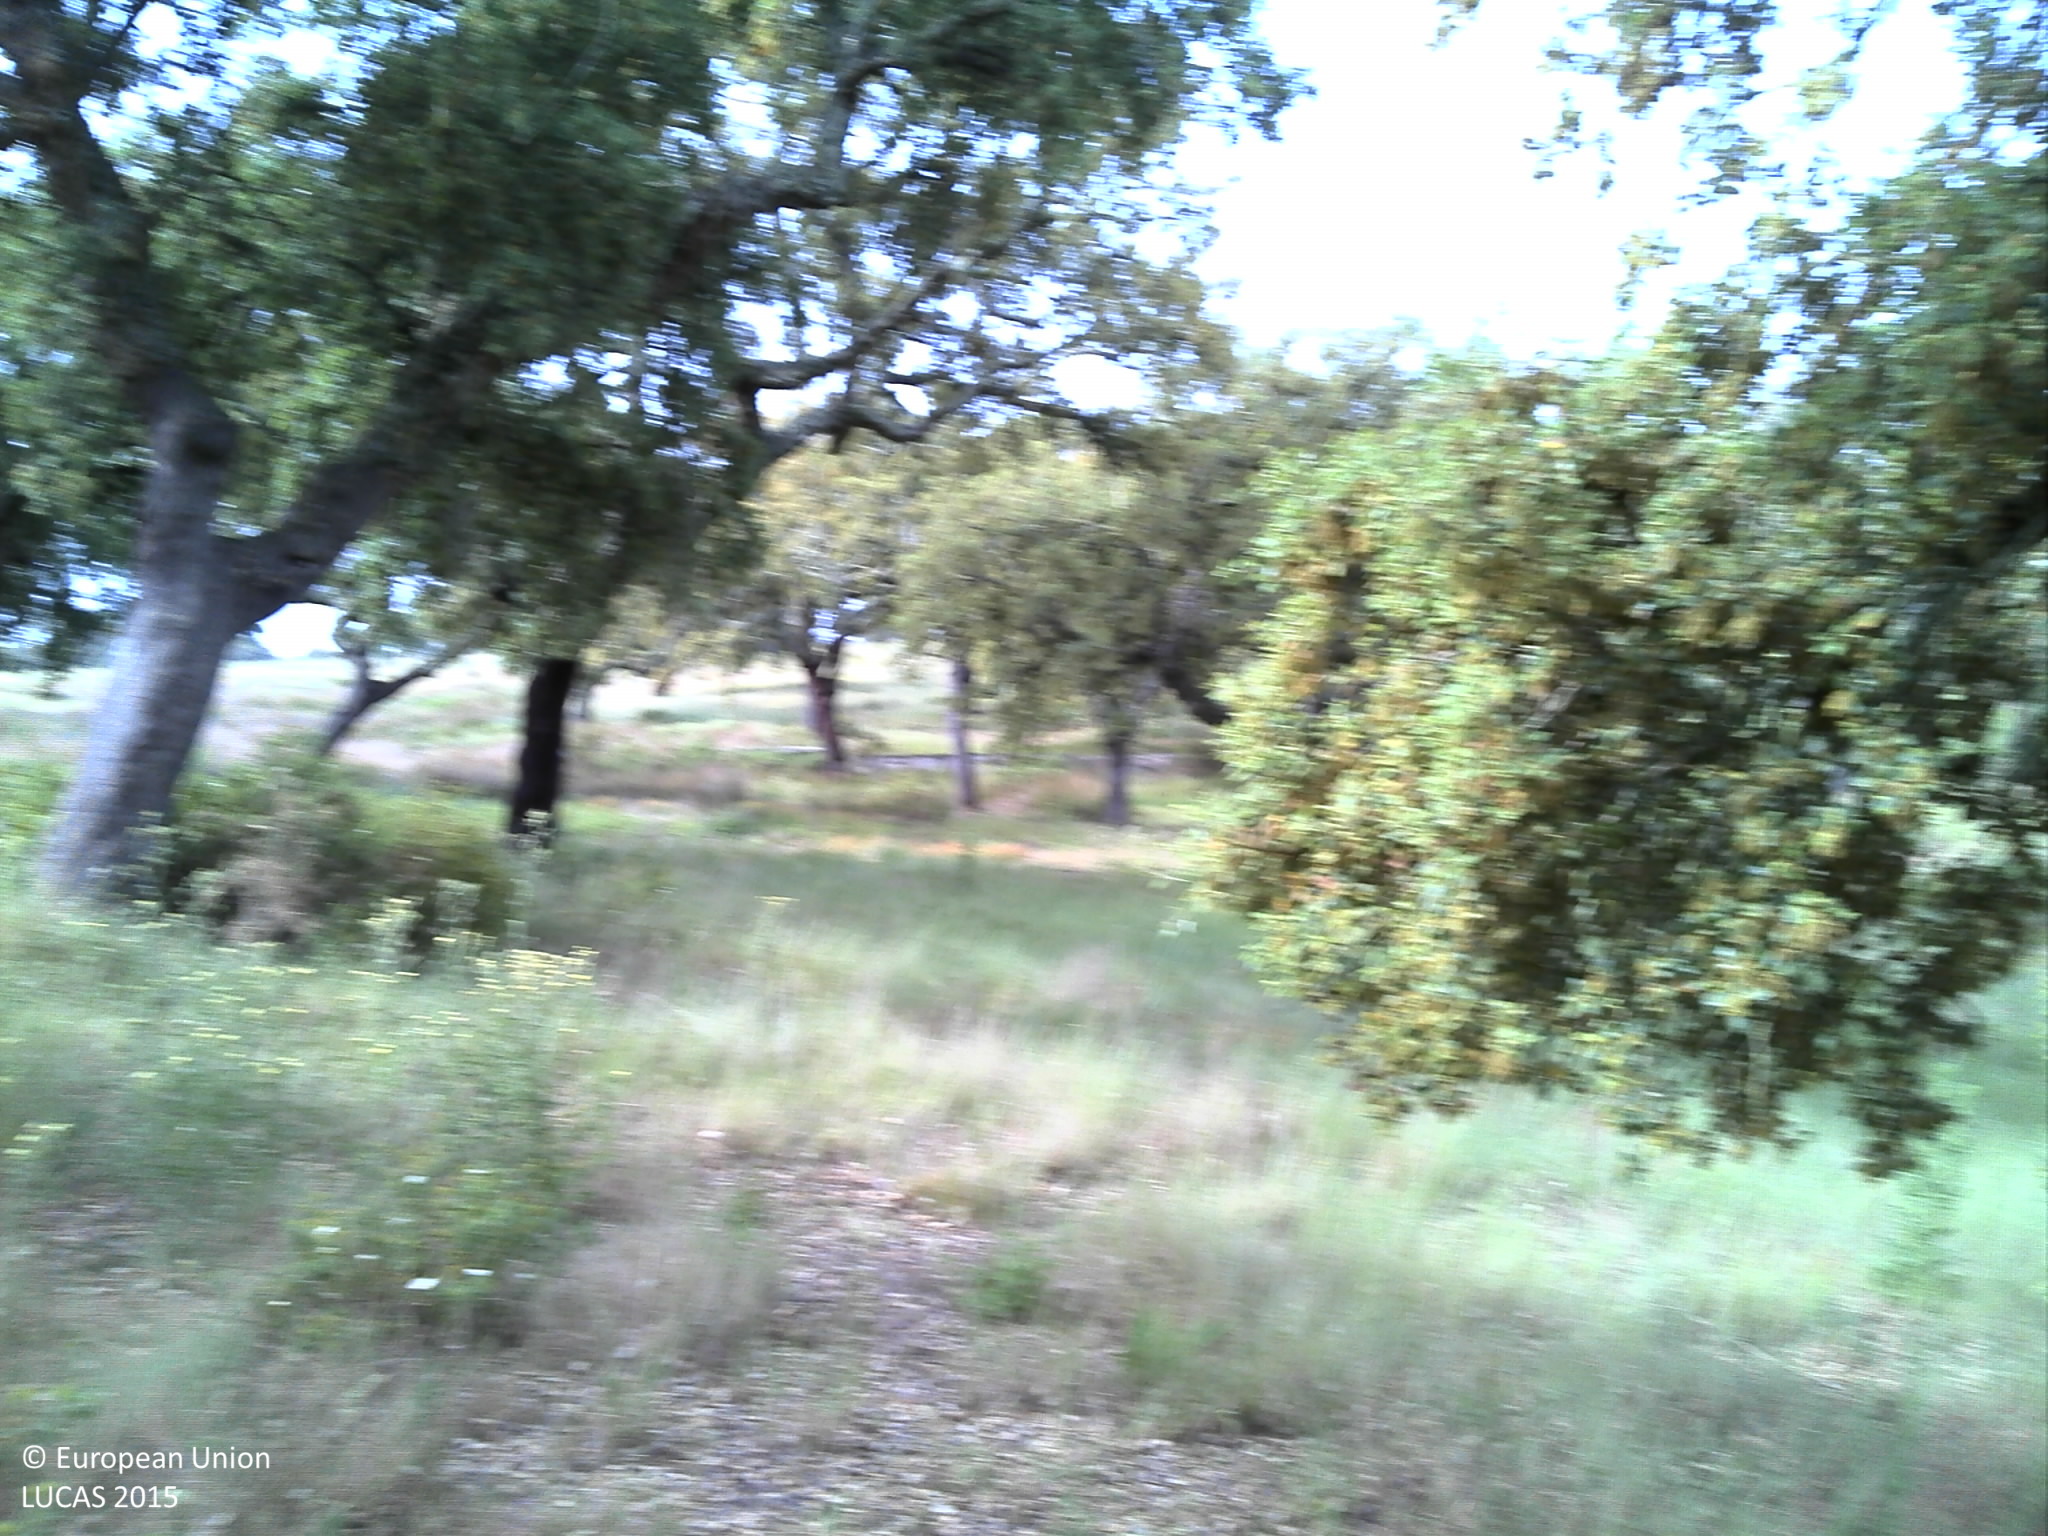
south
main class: Woodland
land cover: Broadleaved woodland
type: broadleaved evergreen forest
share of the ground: 25 - 50 %
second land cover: Shrubland without tree cover
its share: < 10 %
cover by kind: herbaceous plants 45 %, broadleaved forest trees 30 %, shrubs 15 %, unconsolidated bare surface 10 %
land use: Forestry
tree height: > 5 m
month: May
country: PT
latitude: 39.0936
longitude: -7.9601
